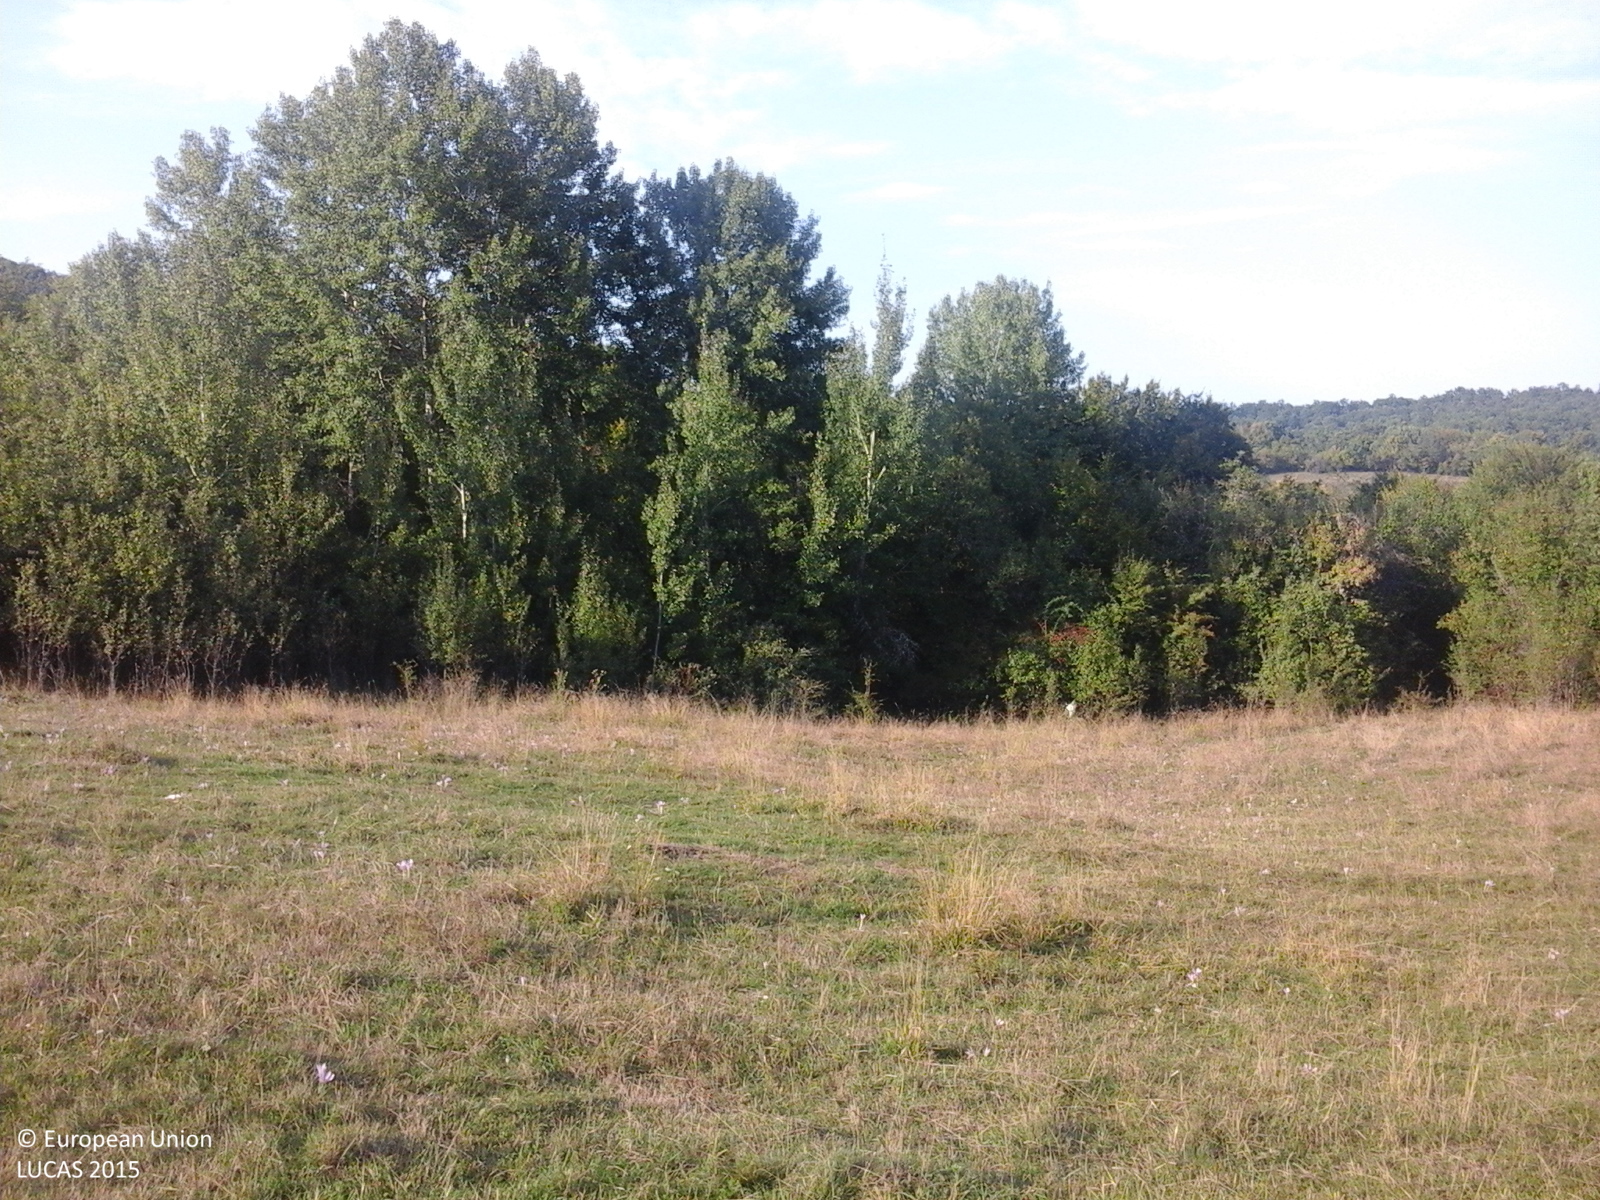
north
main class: Grassland
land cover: Grassland without tree/shrub cover
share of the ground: > 75 %
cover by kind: herbaceous plants 100 %
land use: Agriculture (excluding fallow land and kitchen gardens)
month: September
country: RO
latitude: 45.7732
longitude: 22.8480
